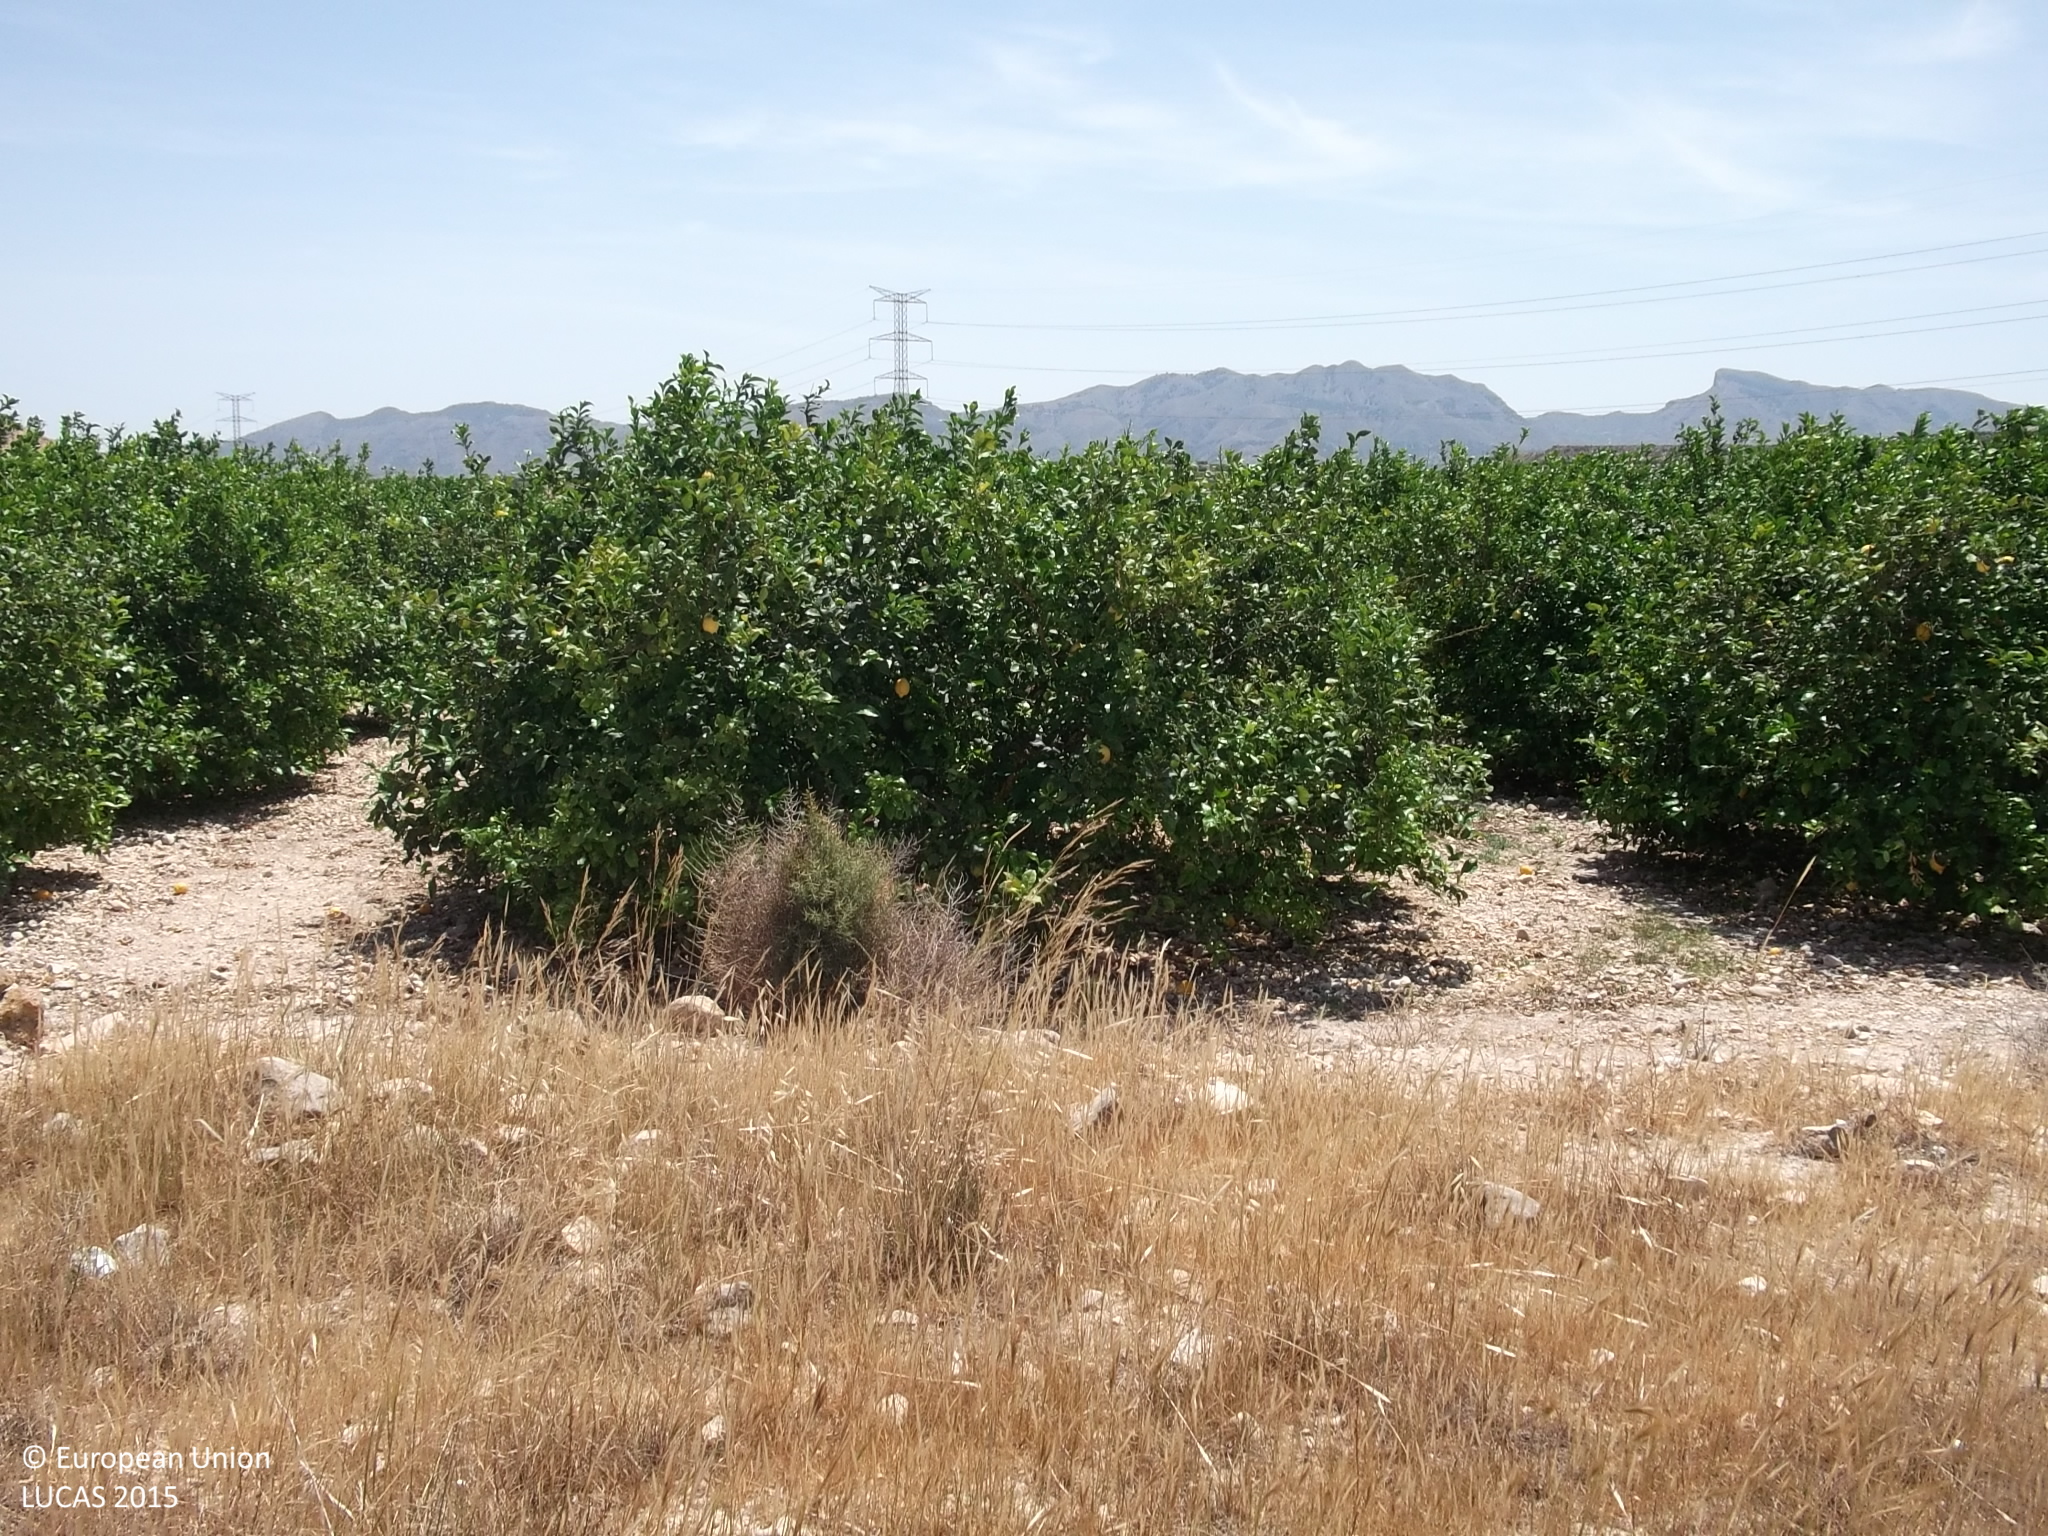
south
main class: Grassland
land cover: Grassland without tree/shrub cover
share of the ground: 10 - 25 %
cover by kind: herbaceous plants 50 %, consolidated bare surface 45 %, shrubs 5 %
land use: Abandoned areas
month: May
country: ES
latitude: 38.1857
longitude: -1.0029
